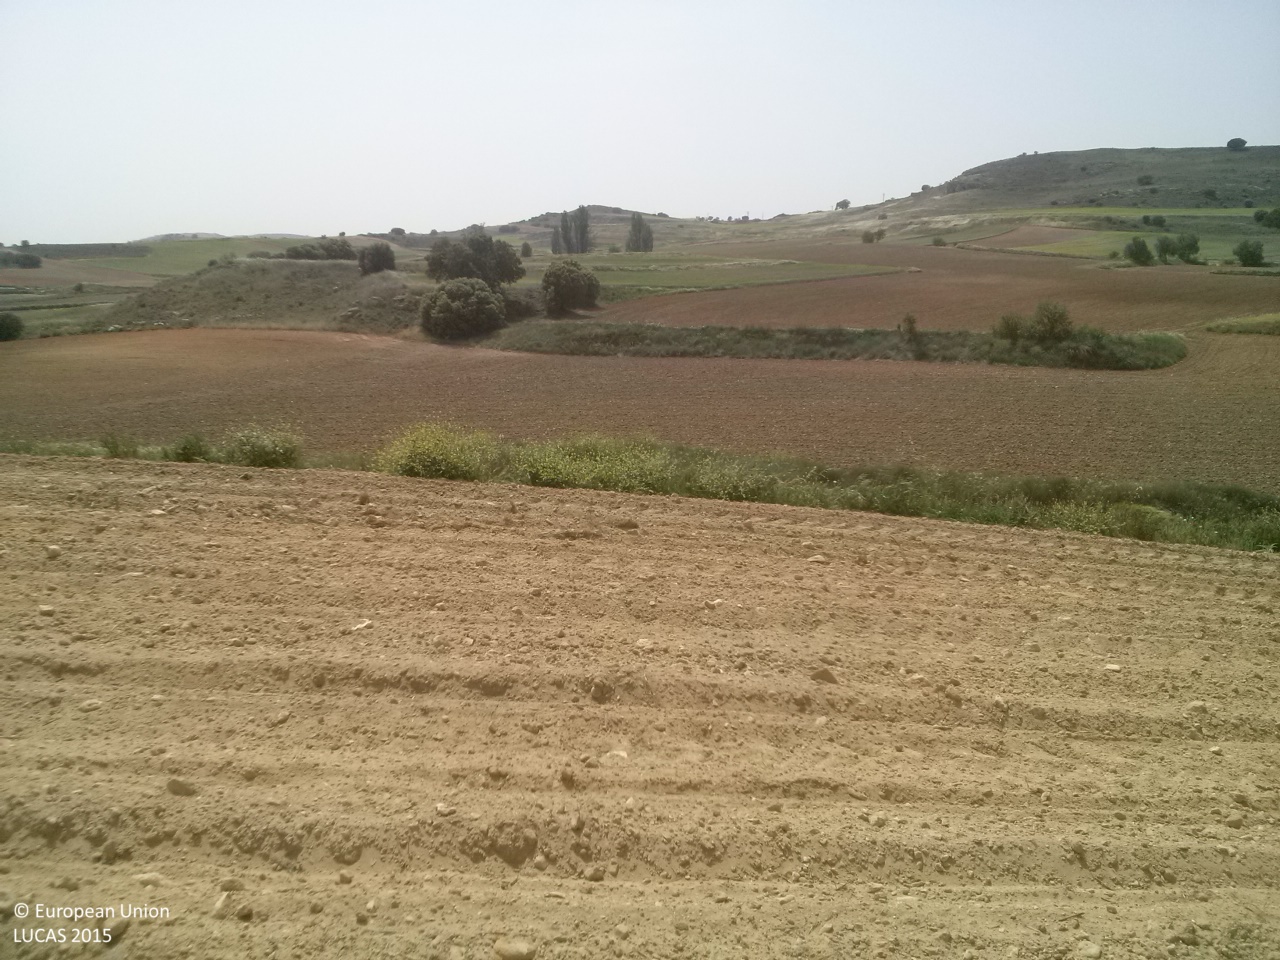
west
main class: Cropland
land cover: Sunflower
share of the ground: < 10 %
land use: Agriculture (excluding fallow land and kitchen gardens)
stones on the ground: 10 - 25 %
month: May
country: ES
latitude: 39.9185
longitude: -2.5242
